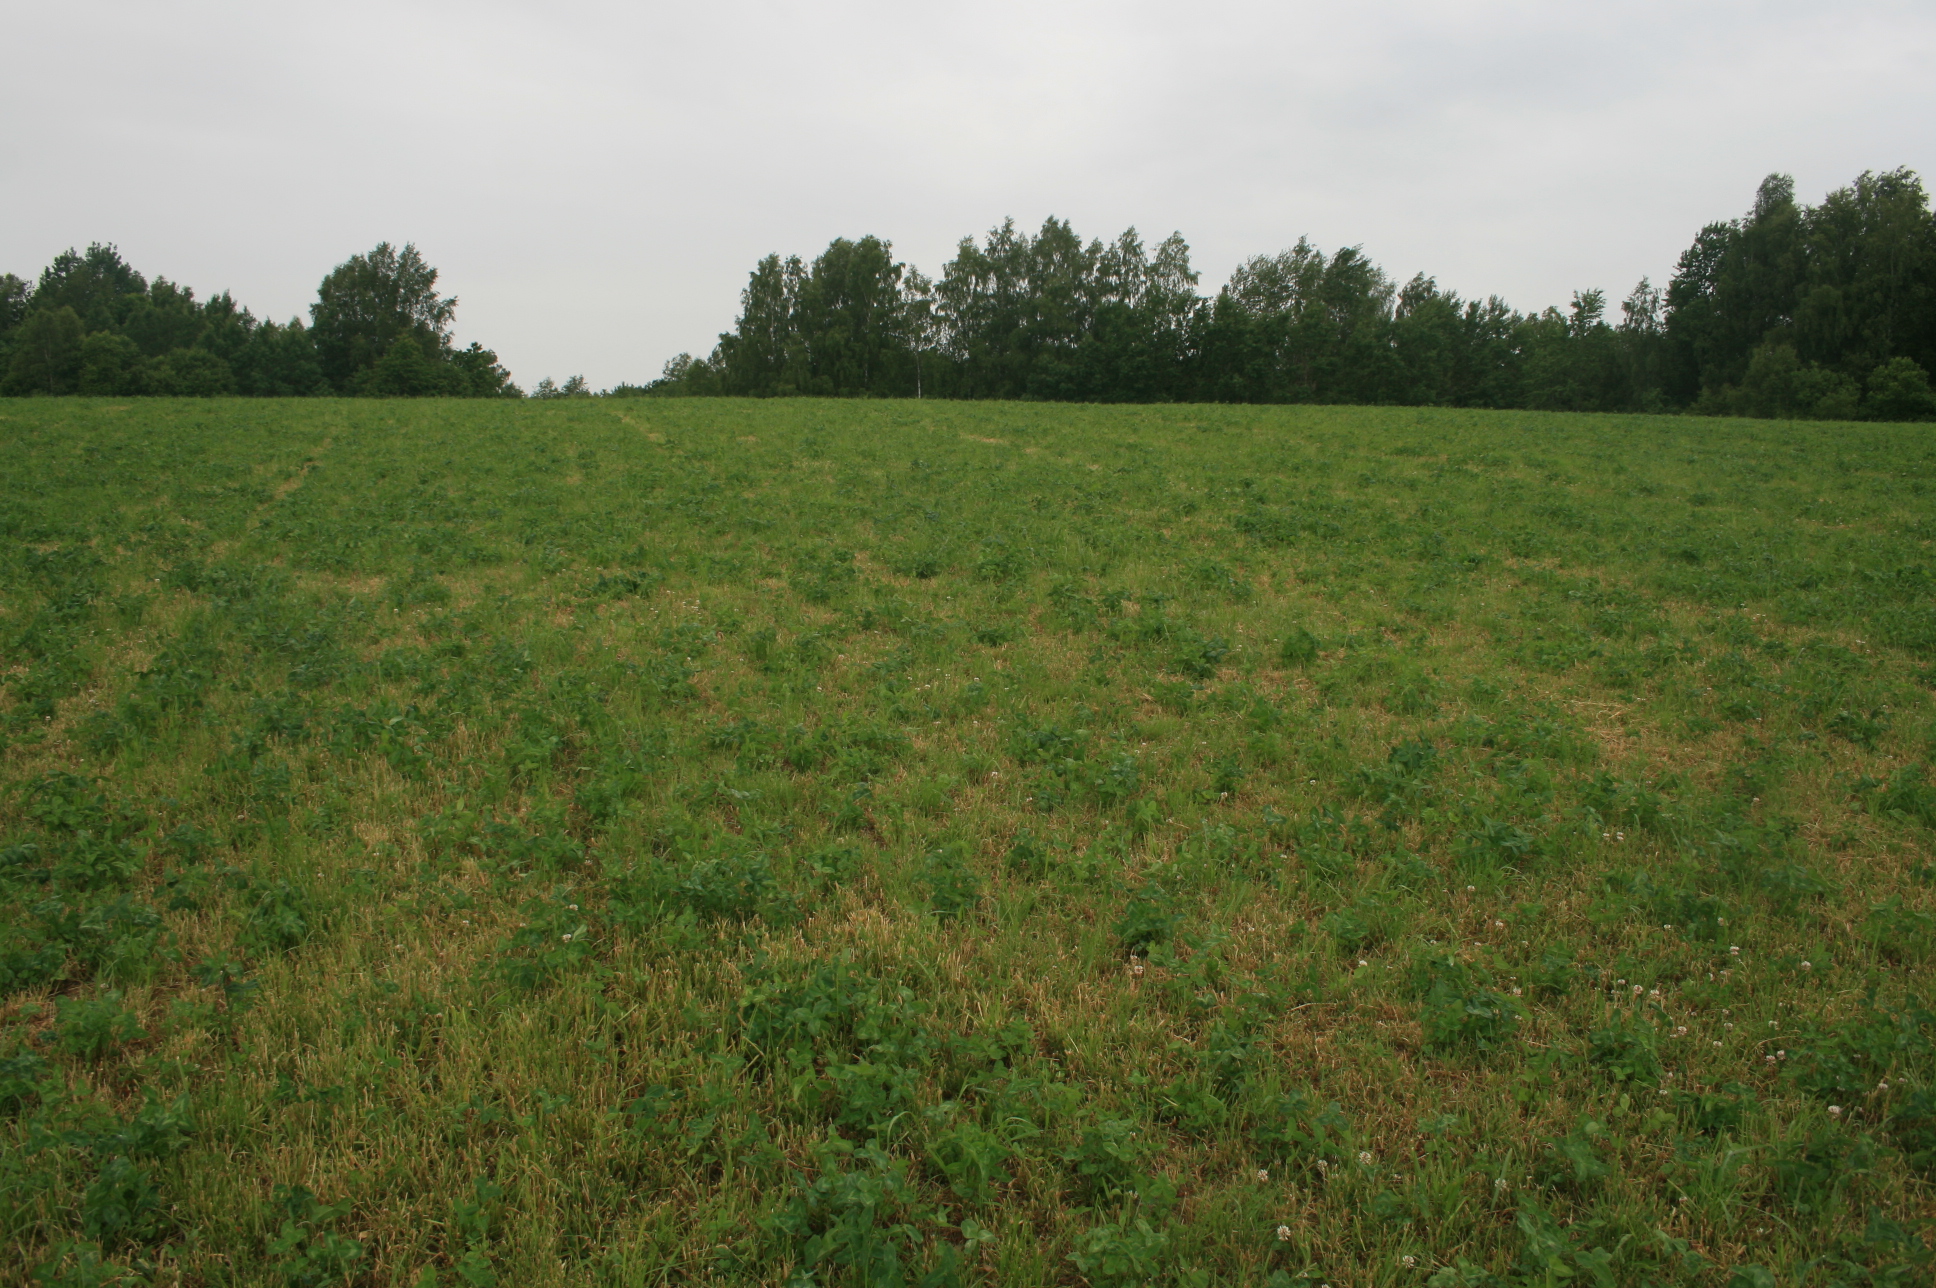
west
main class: Grassland
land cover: Grassland without tree/shrub cover
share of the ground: > 75 %
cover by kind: herbaceous plants 100 %
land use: Agriculture (excluding fallow land and kitchen gardens)
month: June
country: LT
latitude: 55.5172
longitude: 22.3324
